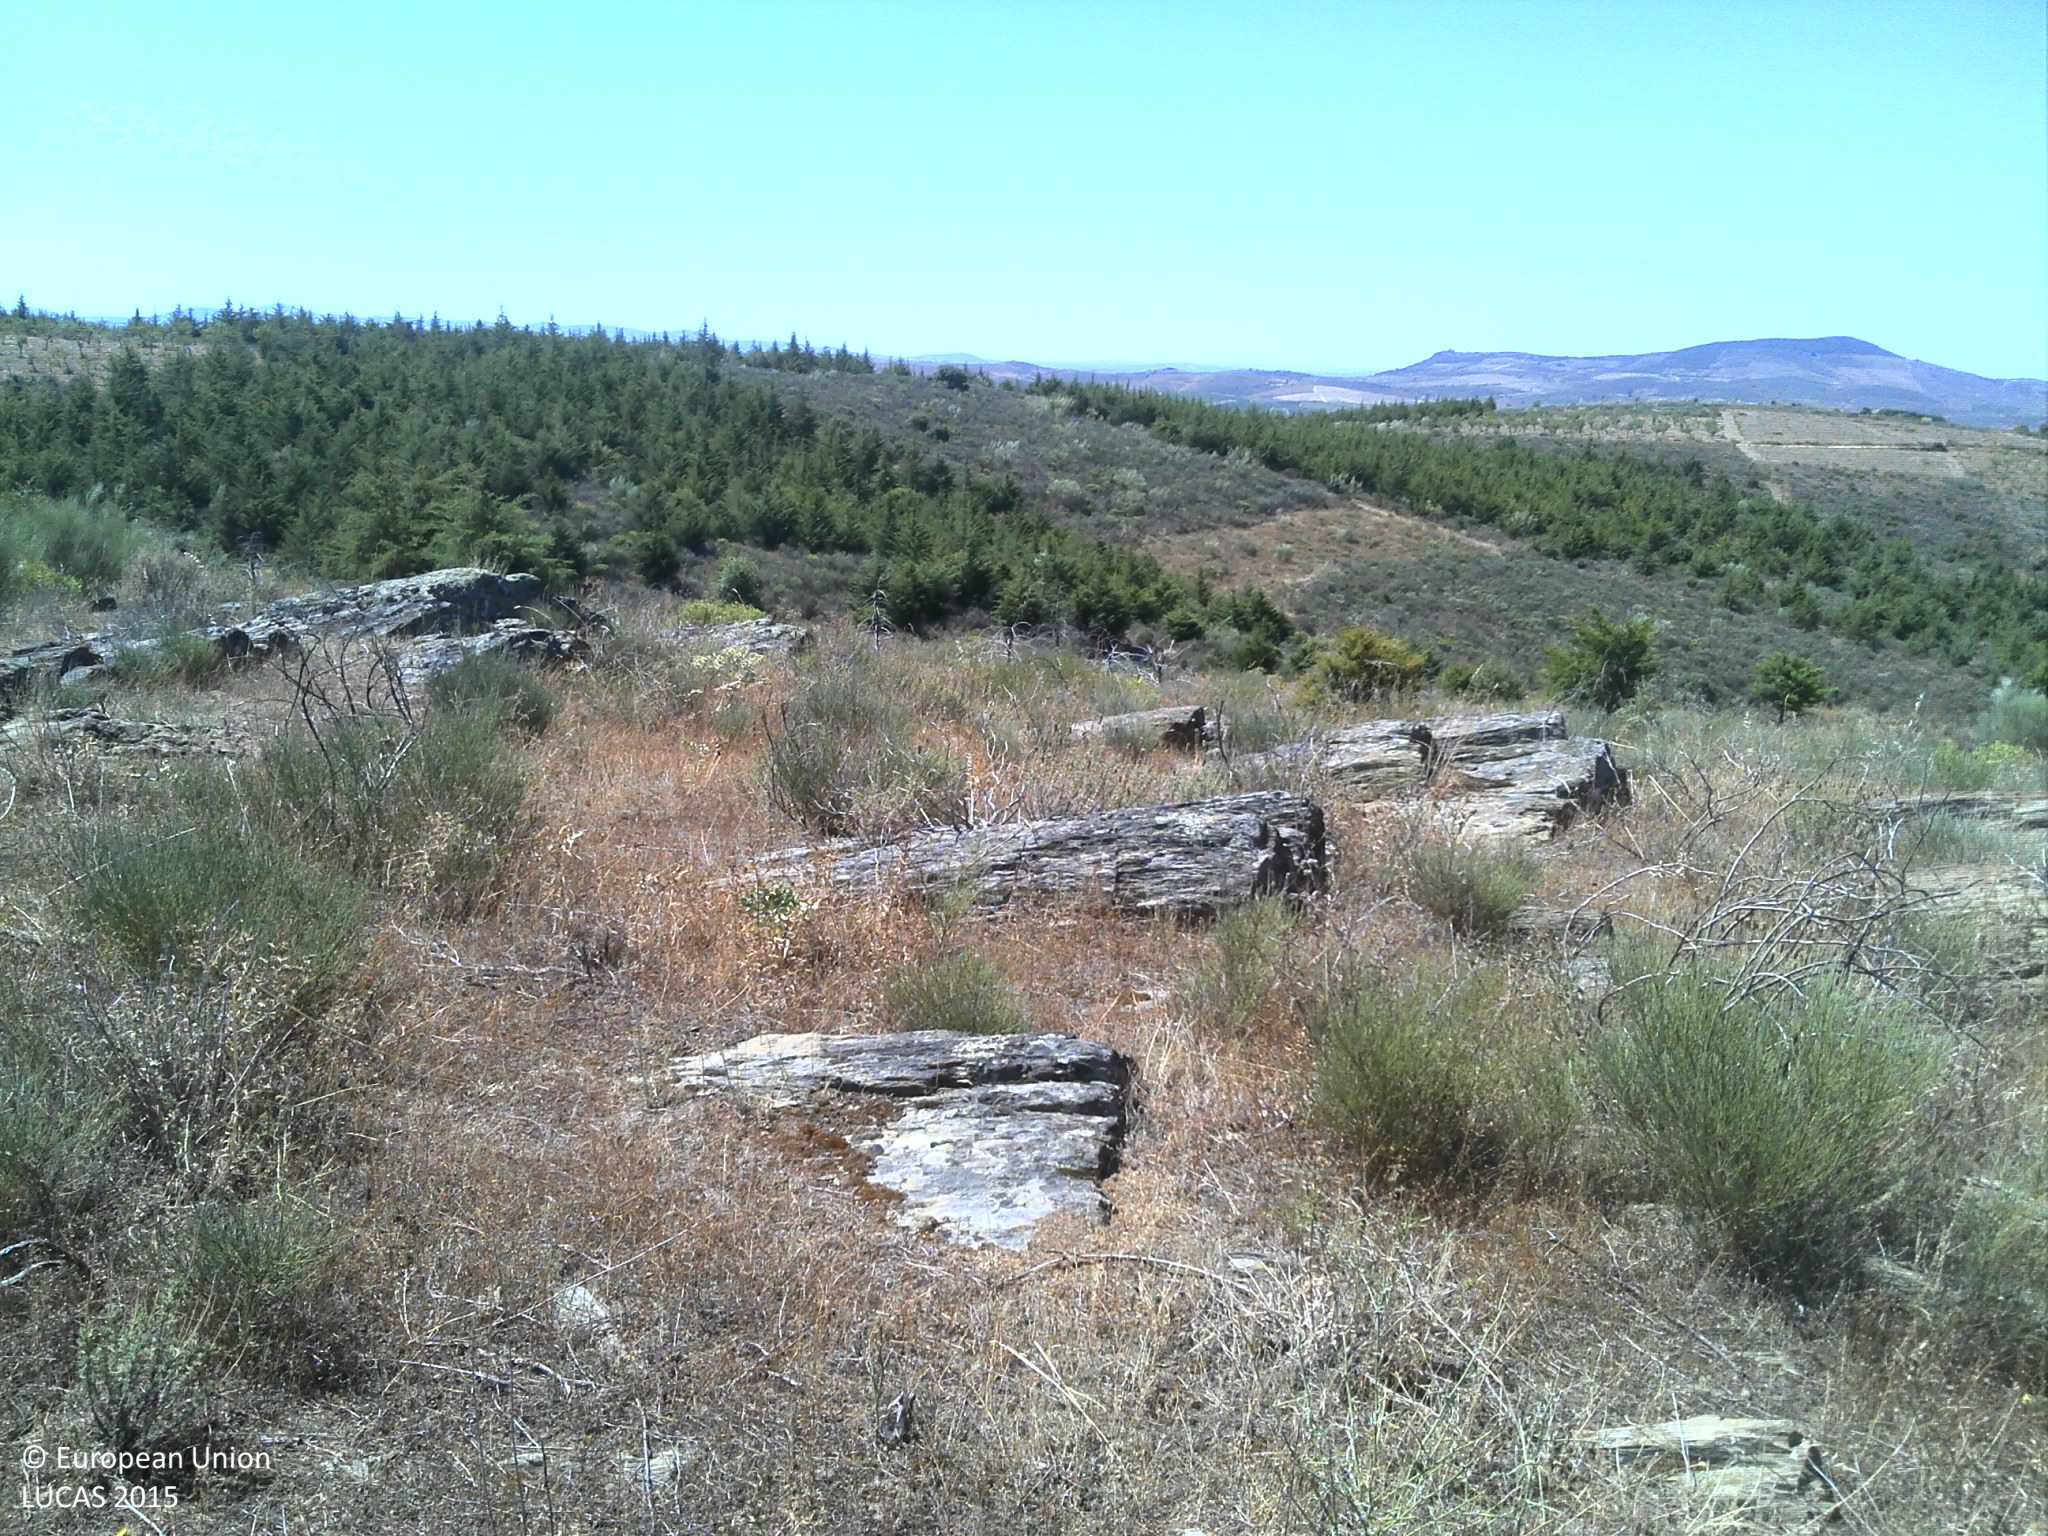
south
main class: Shrubland
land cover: Shrubland without tree cover
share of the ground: 50 - 75 %
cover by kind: shrubs 75 %, herbaceous plants 20 %, consolidated bare surface 5 %
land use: Abandoned areas
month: July
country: PT
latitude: 41.0855
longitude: -7.0486
